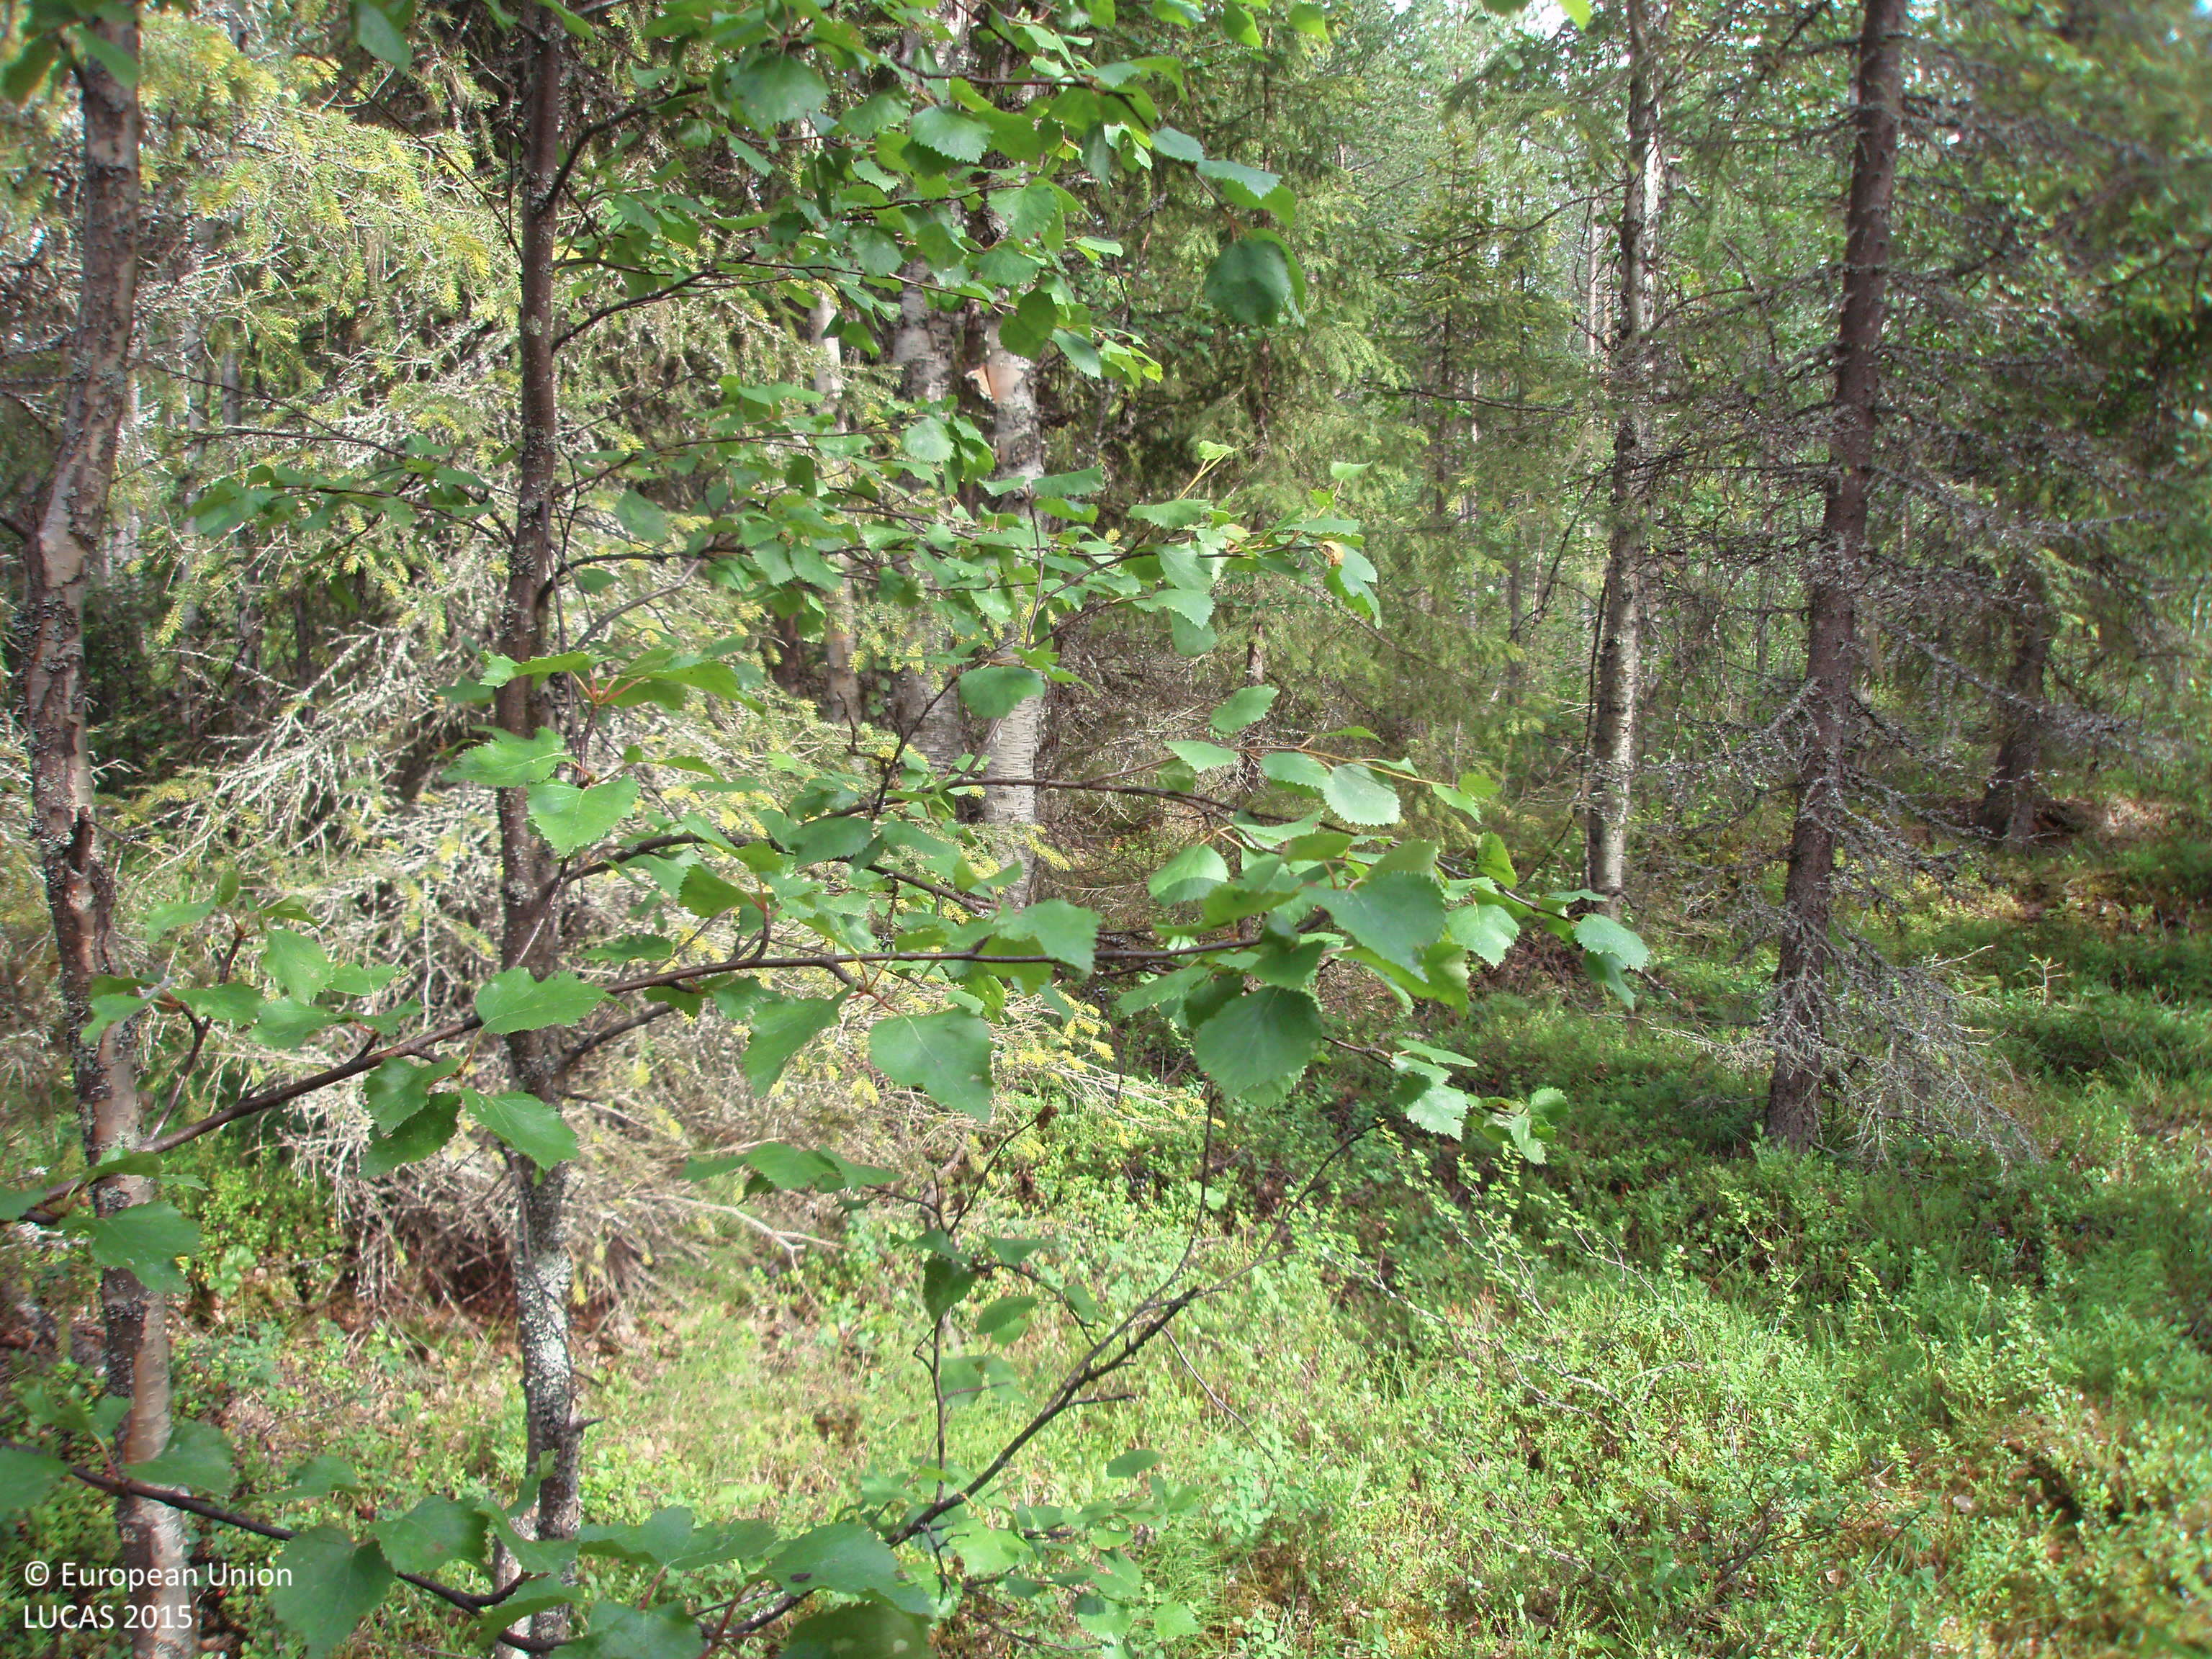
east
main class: Woodland
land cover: Other mixed woodland
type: boreal forest
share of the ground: > 75 %
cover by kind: coniferous forest trees 45 %, broadleaved forest trees 40 %, shrubs 15 %
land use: Forestry
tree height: > 5 m
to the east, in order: Other mixed woodland; Ditches and canals; Pine dominated mixed woodland; Ditches and canals; Shrubland without tree cover; Tracks; Pine dominated coniferous woodland; Pine dominated mixed woodland; Tracks; Pine dominated mixed woodland
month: July
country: FI
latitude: 66.9322
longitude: 28.5987
